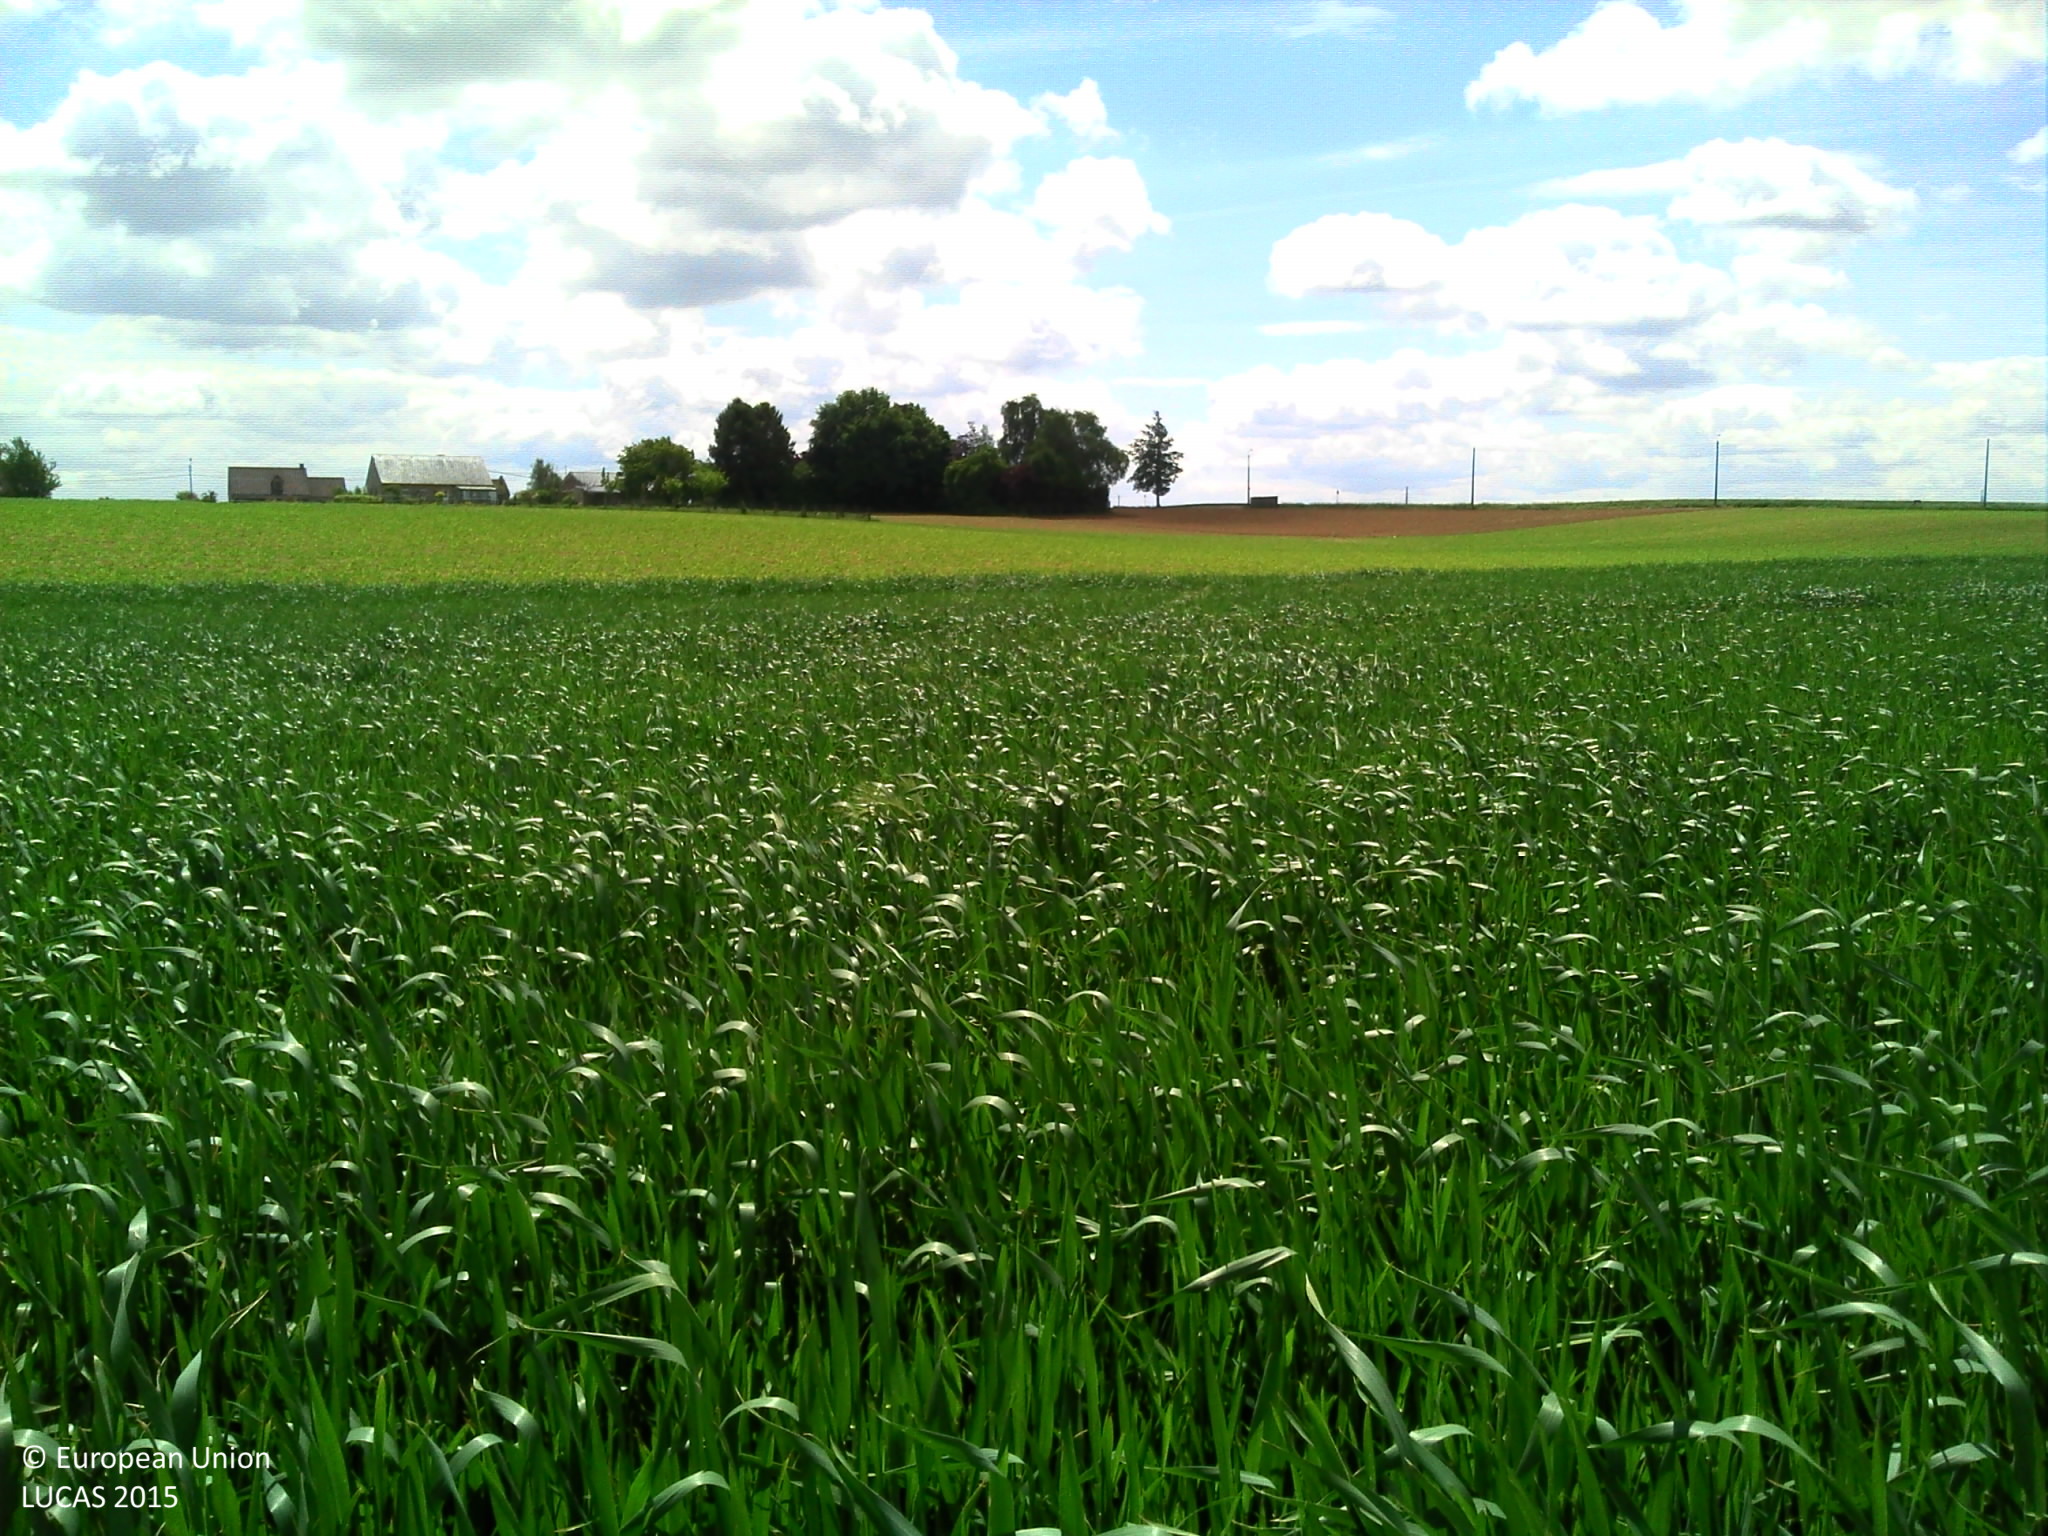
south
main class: Cropland
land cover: Common wheat
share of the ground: > 75 %
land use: Agriculture (excluding fallow land and kitchen gardens)
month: May
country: BE
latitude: 50.6561
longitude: 5.1173
